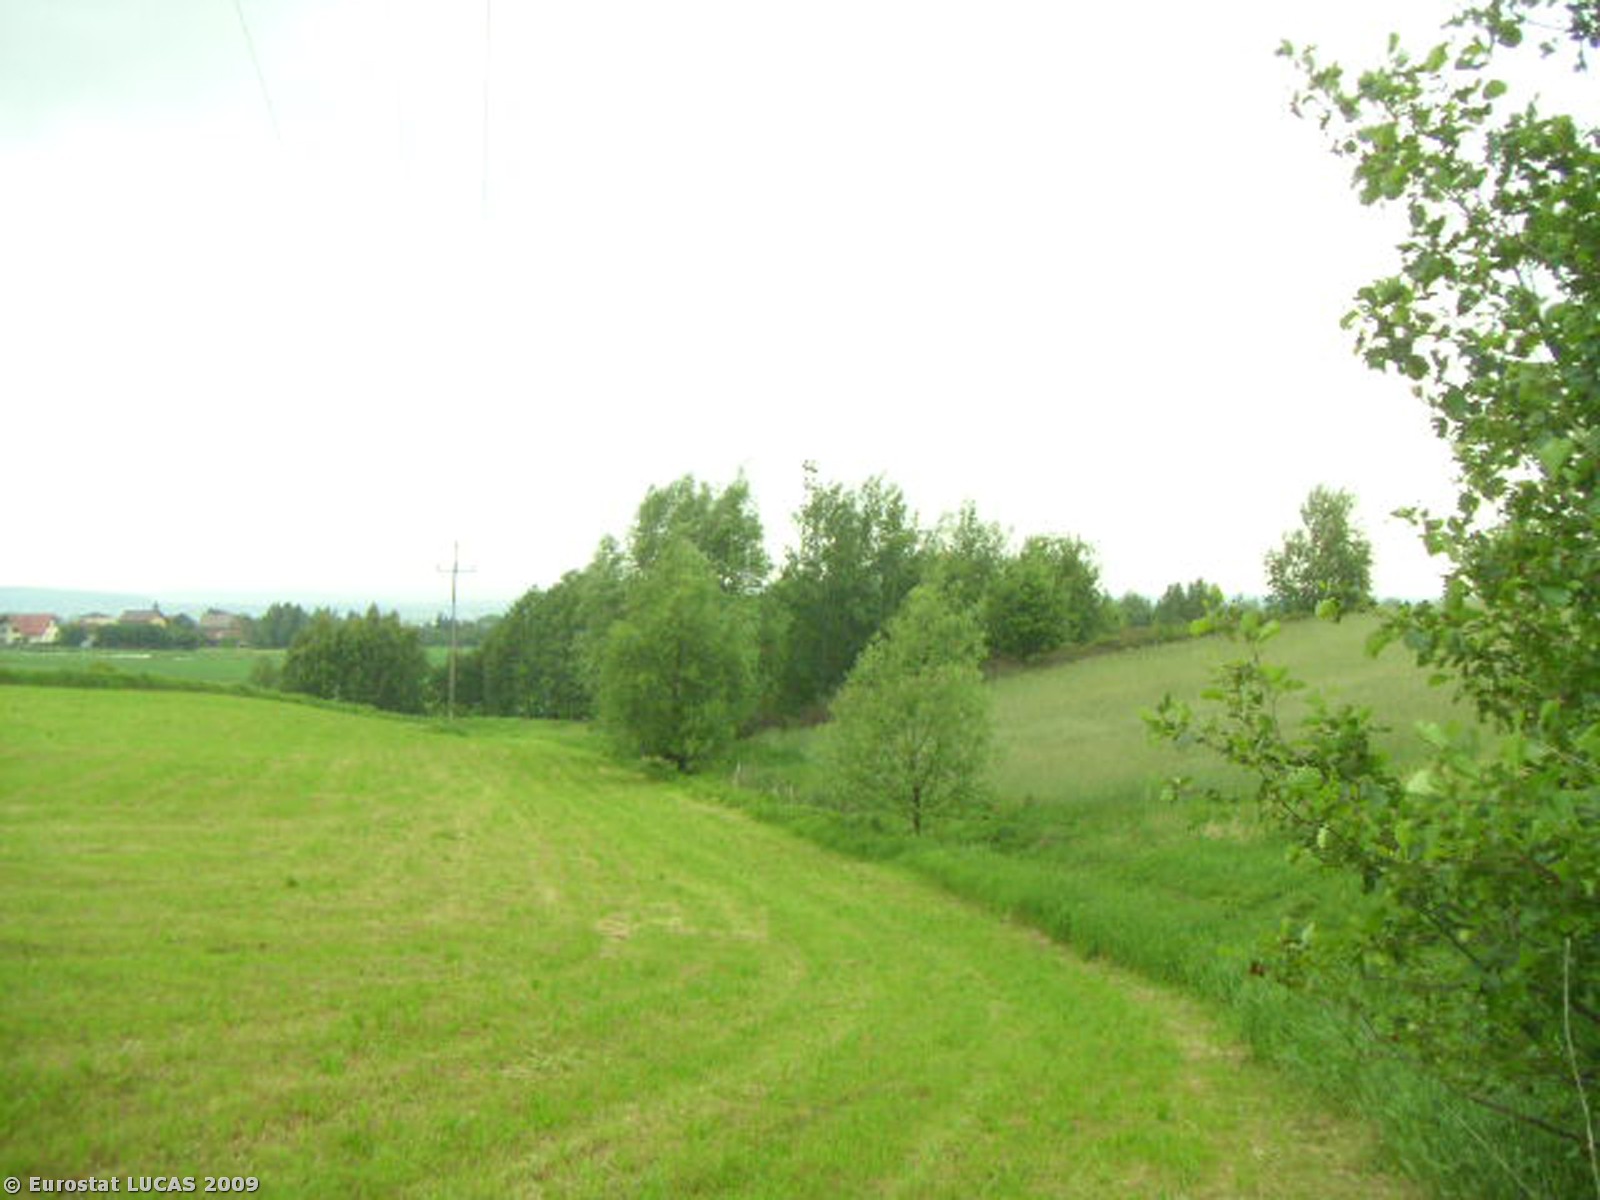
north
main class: Grassland
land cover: Spontaneously vegetated surfaces
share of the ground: > 75 %
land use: Fallow land
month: June
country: PL
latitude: 49.9496
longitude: 19.7151
